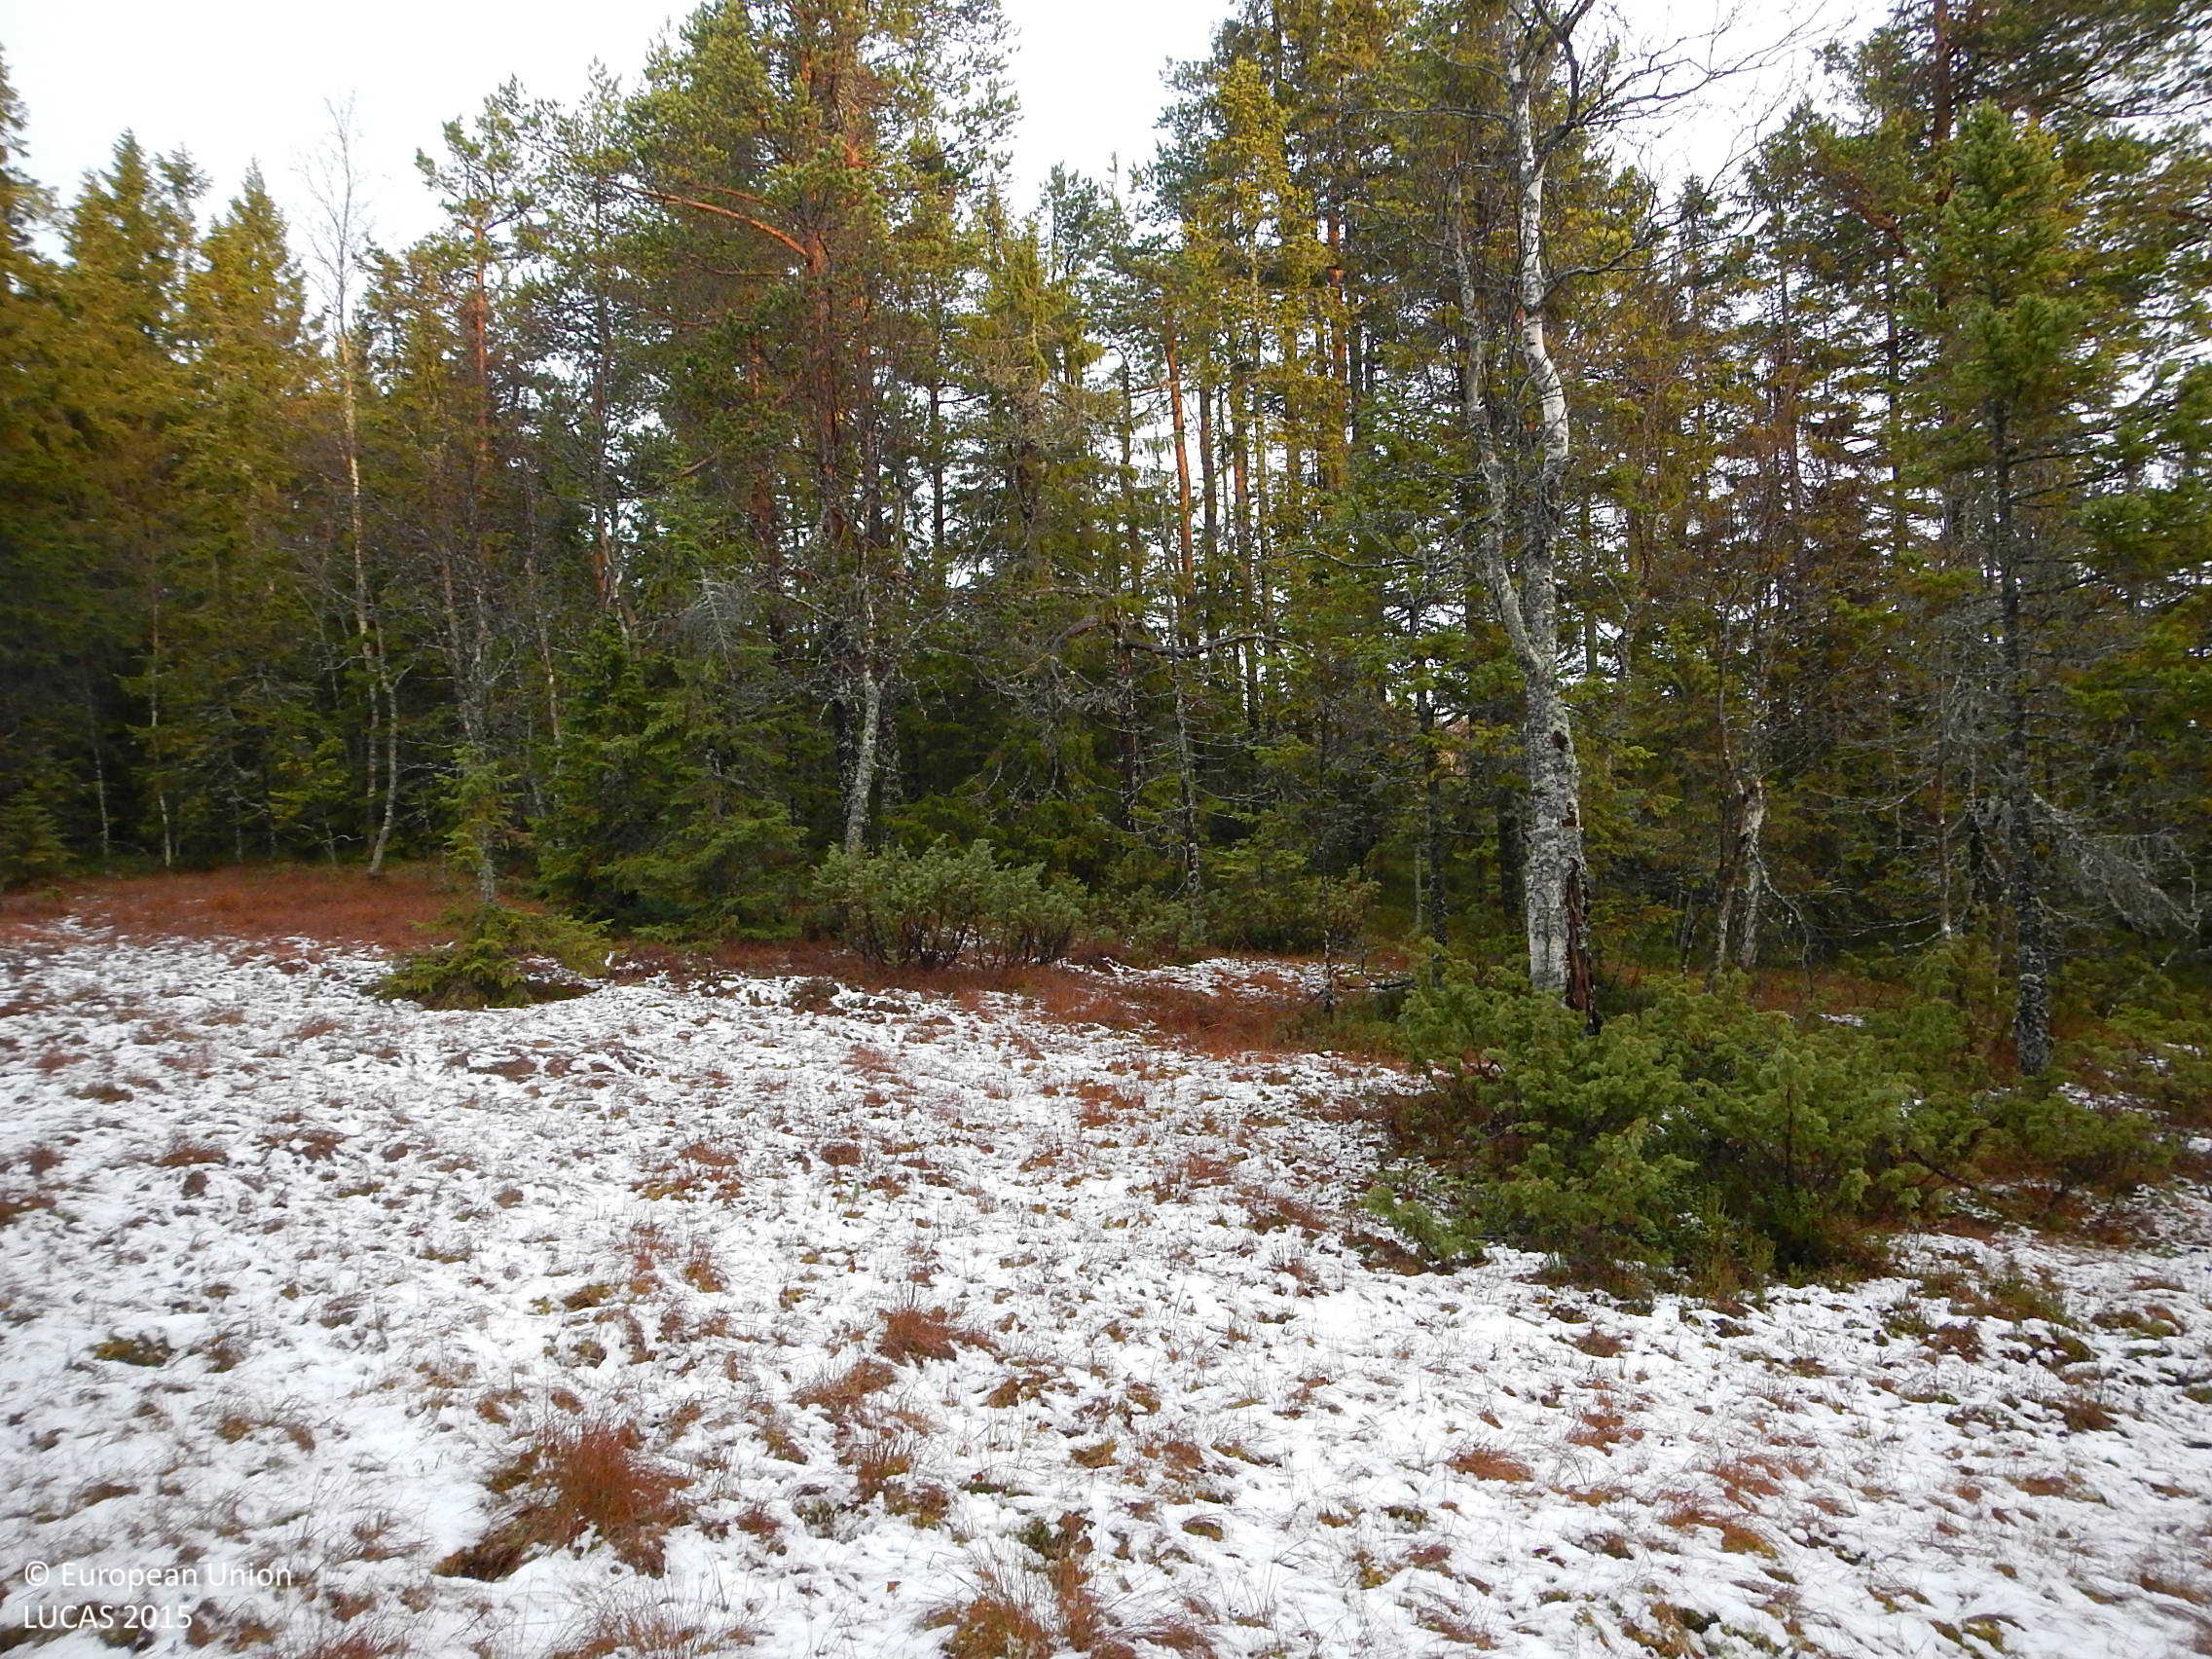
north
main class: Woodland
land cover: Other coniferous woodland
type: boreal forest
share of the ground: 50 - 75 %
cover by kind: coniferous forest trees 70 %, shrubs 20 %, lichens and mosses 10 %
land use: Amenities, museums, leisure
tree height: > 5 m
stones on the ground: < 10 %
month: November
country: SE
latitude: 61.6692
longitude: 16.6514
